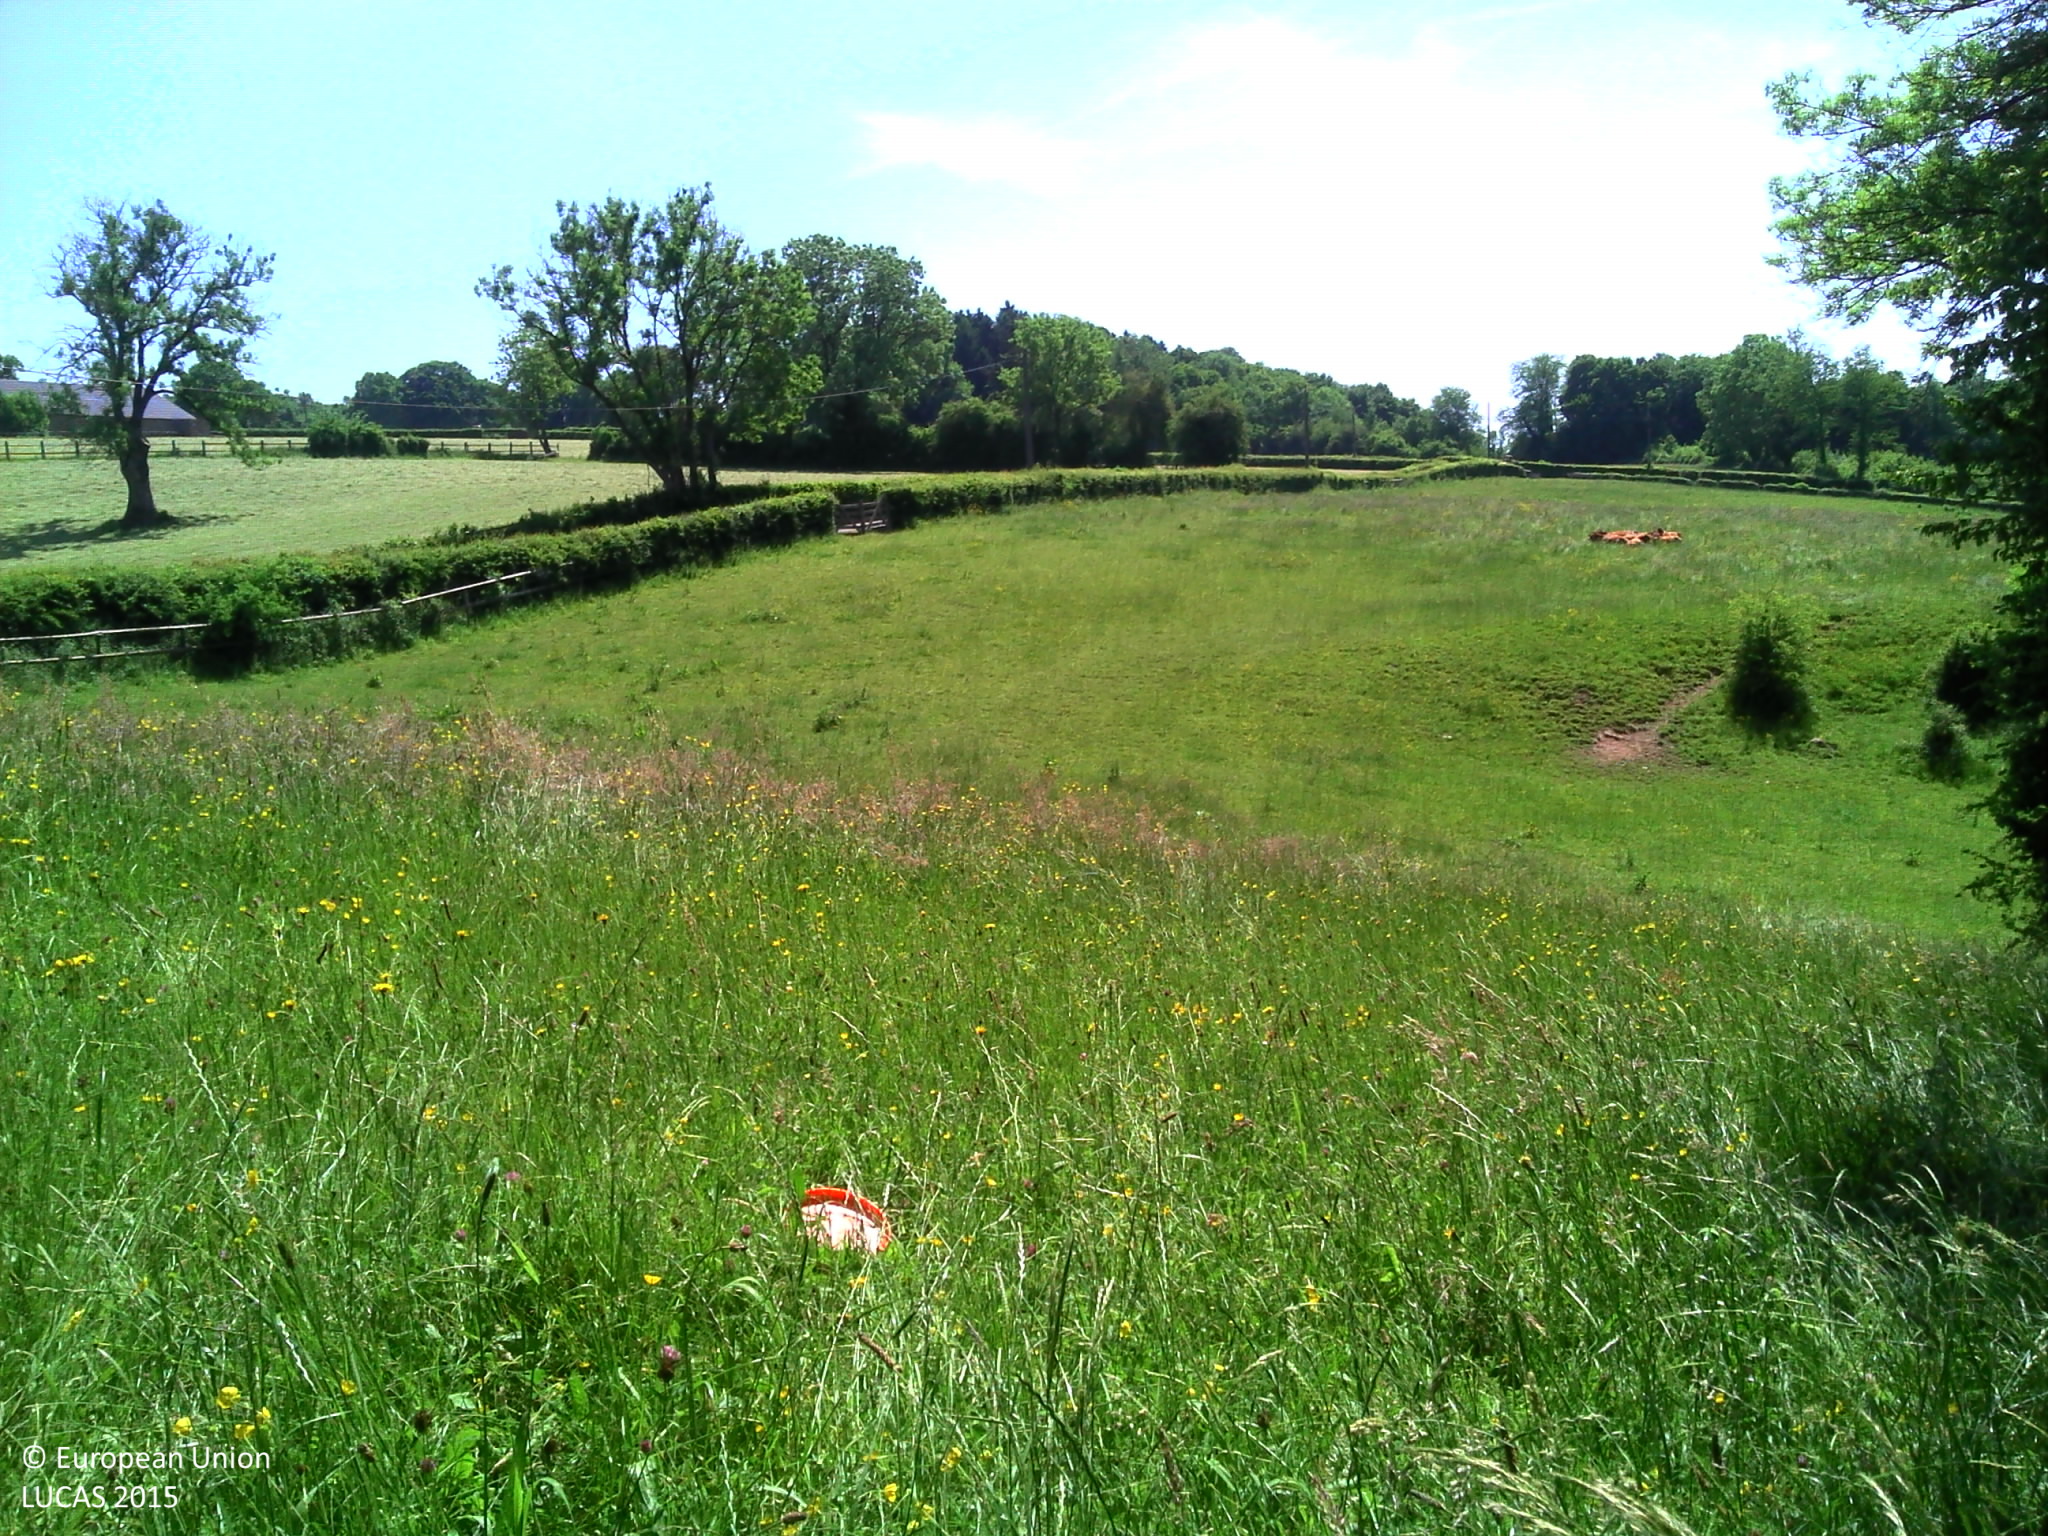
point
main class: Grassland
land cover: Grassland without tree/shrub cover
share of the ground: > 75 %
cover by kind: herbaceous plants 100 %
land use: Agriculture (excluding fallow land and kitchen gardens)
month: June
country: BE
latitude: 50.5003
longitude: 5.7268
